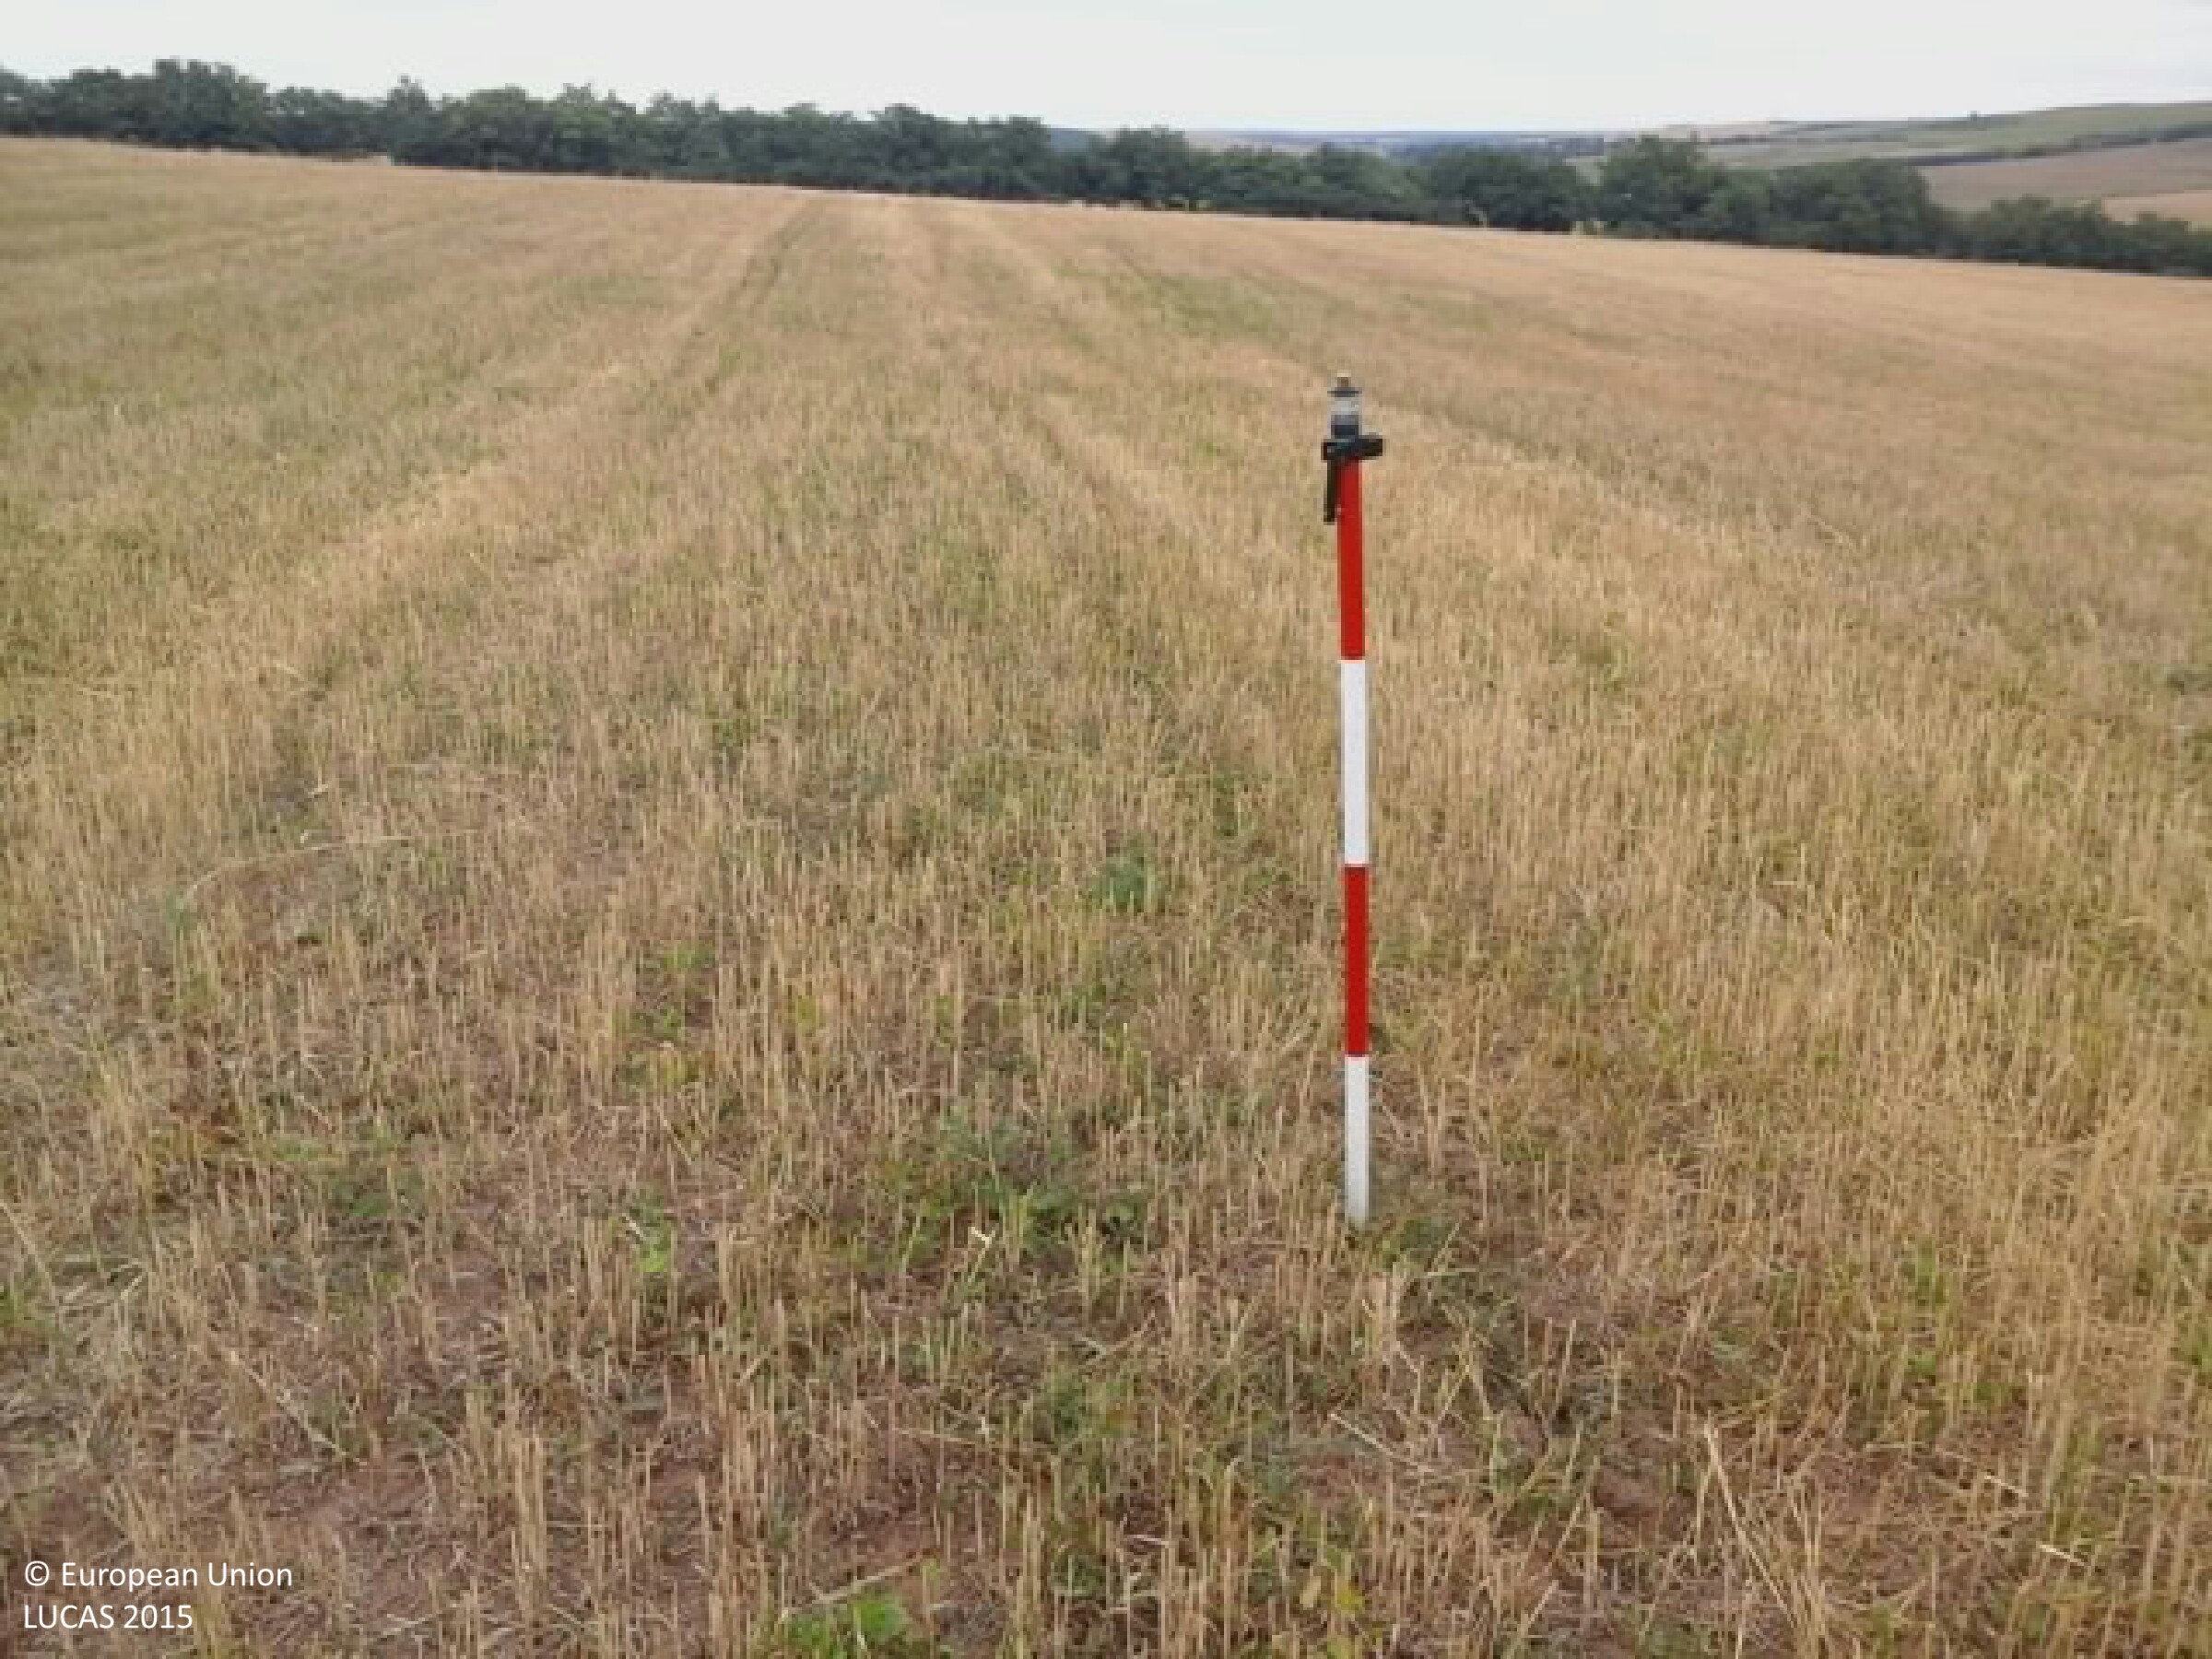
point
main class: Cropland
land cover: Common wheat
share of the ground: 50 - 75 %
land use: Agriculture (excluding fallow land and kitchen gardens)
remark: Harvested field
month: July
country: HU
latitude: 47.7621
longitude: 19.4545
